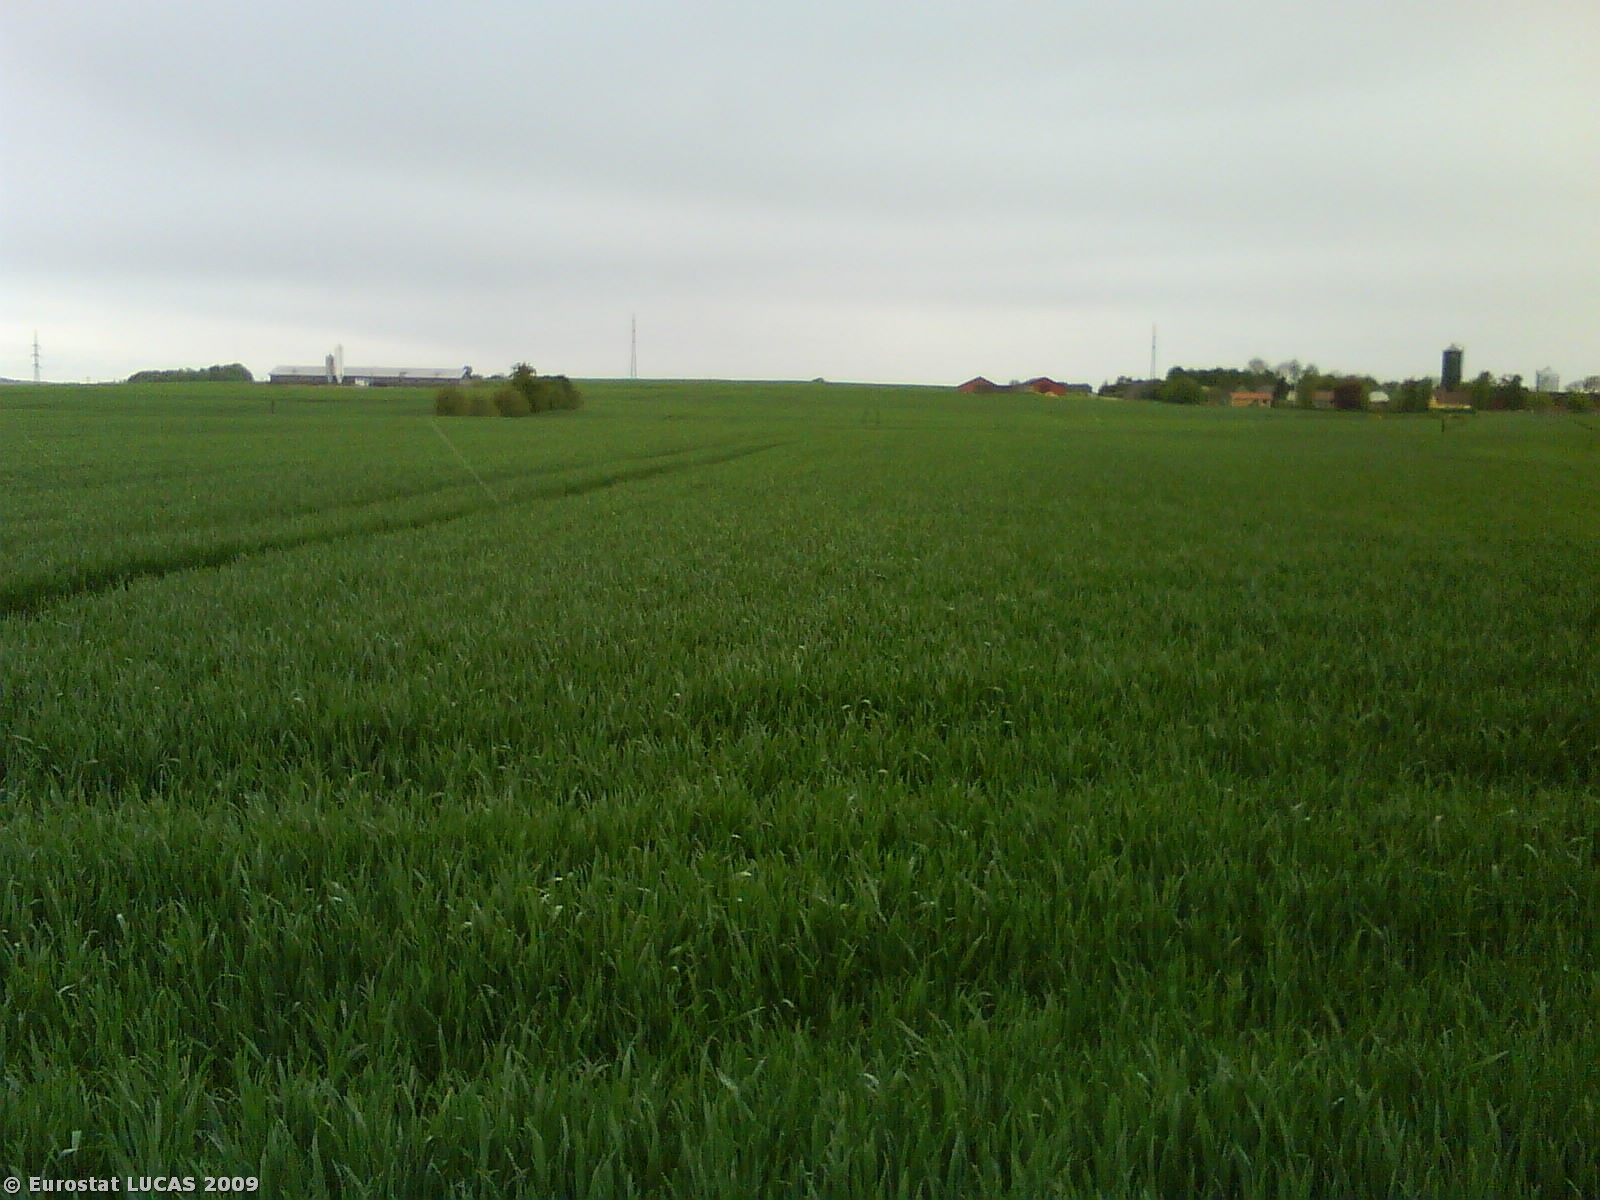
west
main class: Cropland
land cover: Common wheat
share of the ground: > 75 %
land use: Agriculture (excluding fallow land and kitchen gardens)
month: May
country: DK
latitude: 56.3315
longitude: 10.1454
